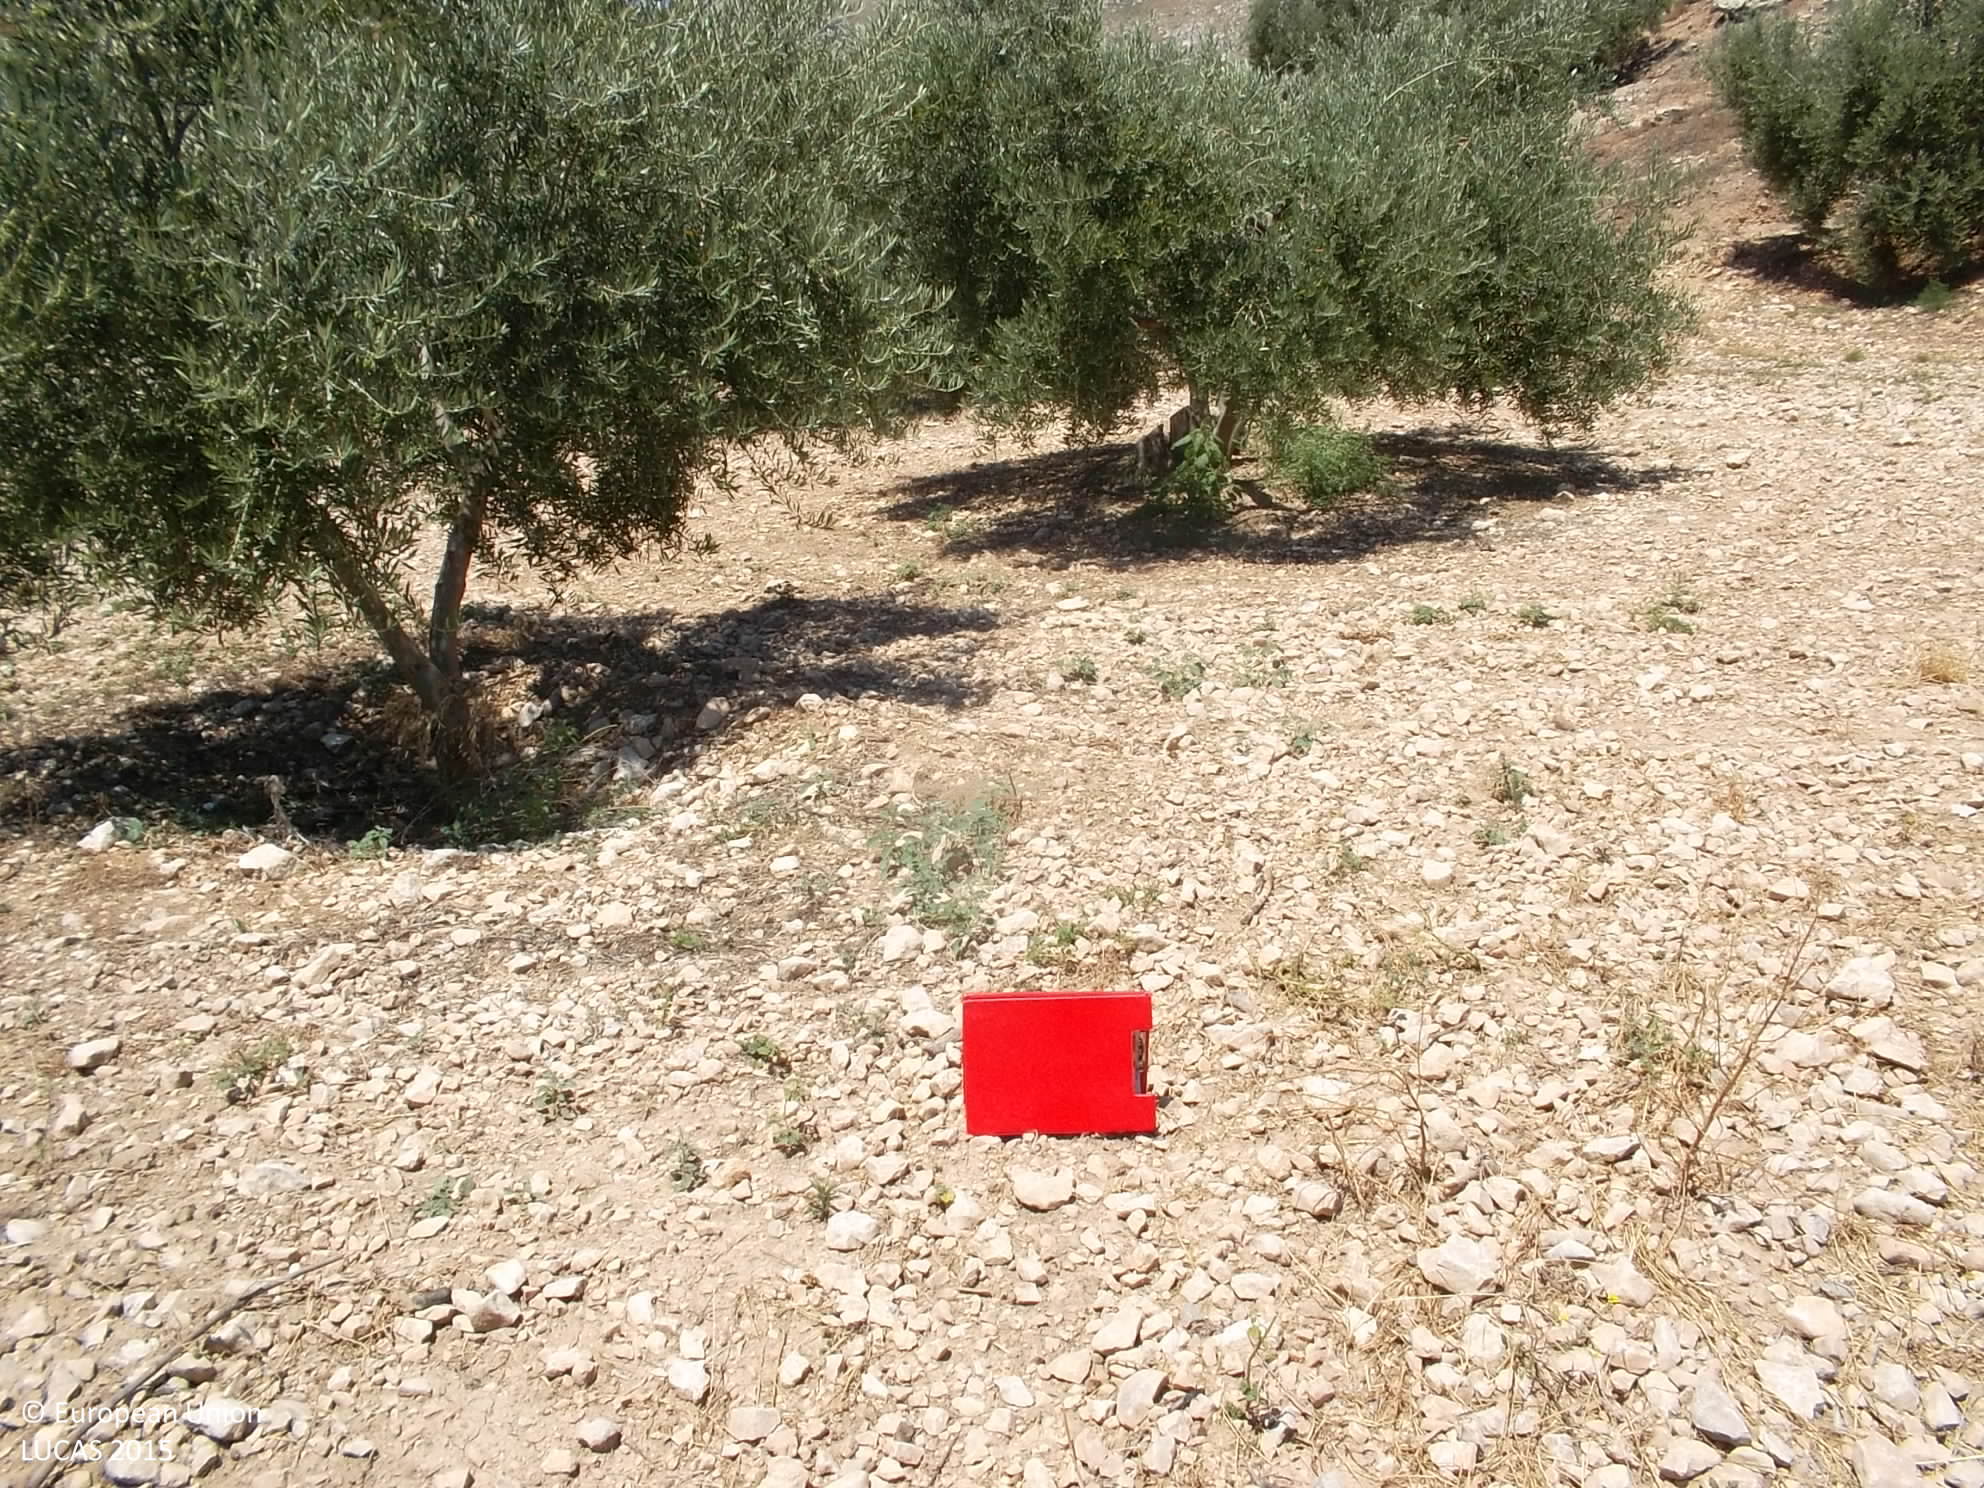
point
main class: Cropland
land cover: Olive groves
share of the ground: 25 - 50 %
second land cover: Grassland without tree/shrub cover
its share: 10 - 25 %
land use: Agriculture (excluding fallow land and kitchen gardens)
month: June
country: ES
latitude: 37.8265
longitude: -3.3694
